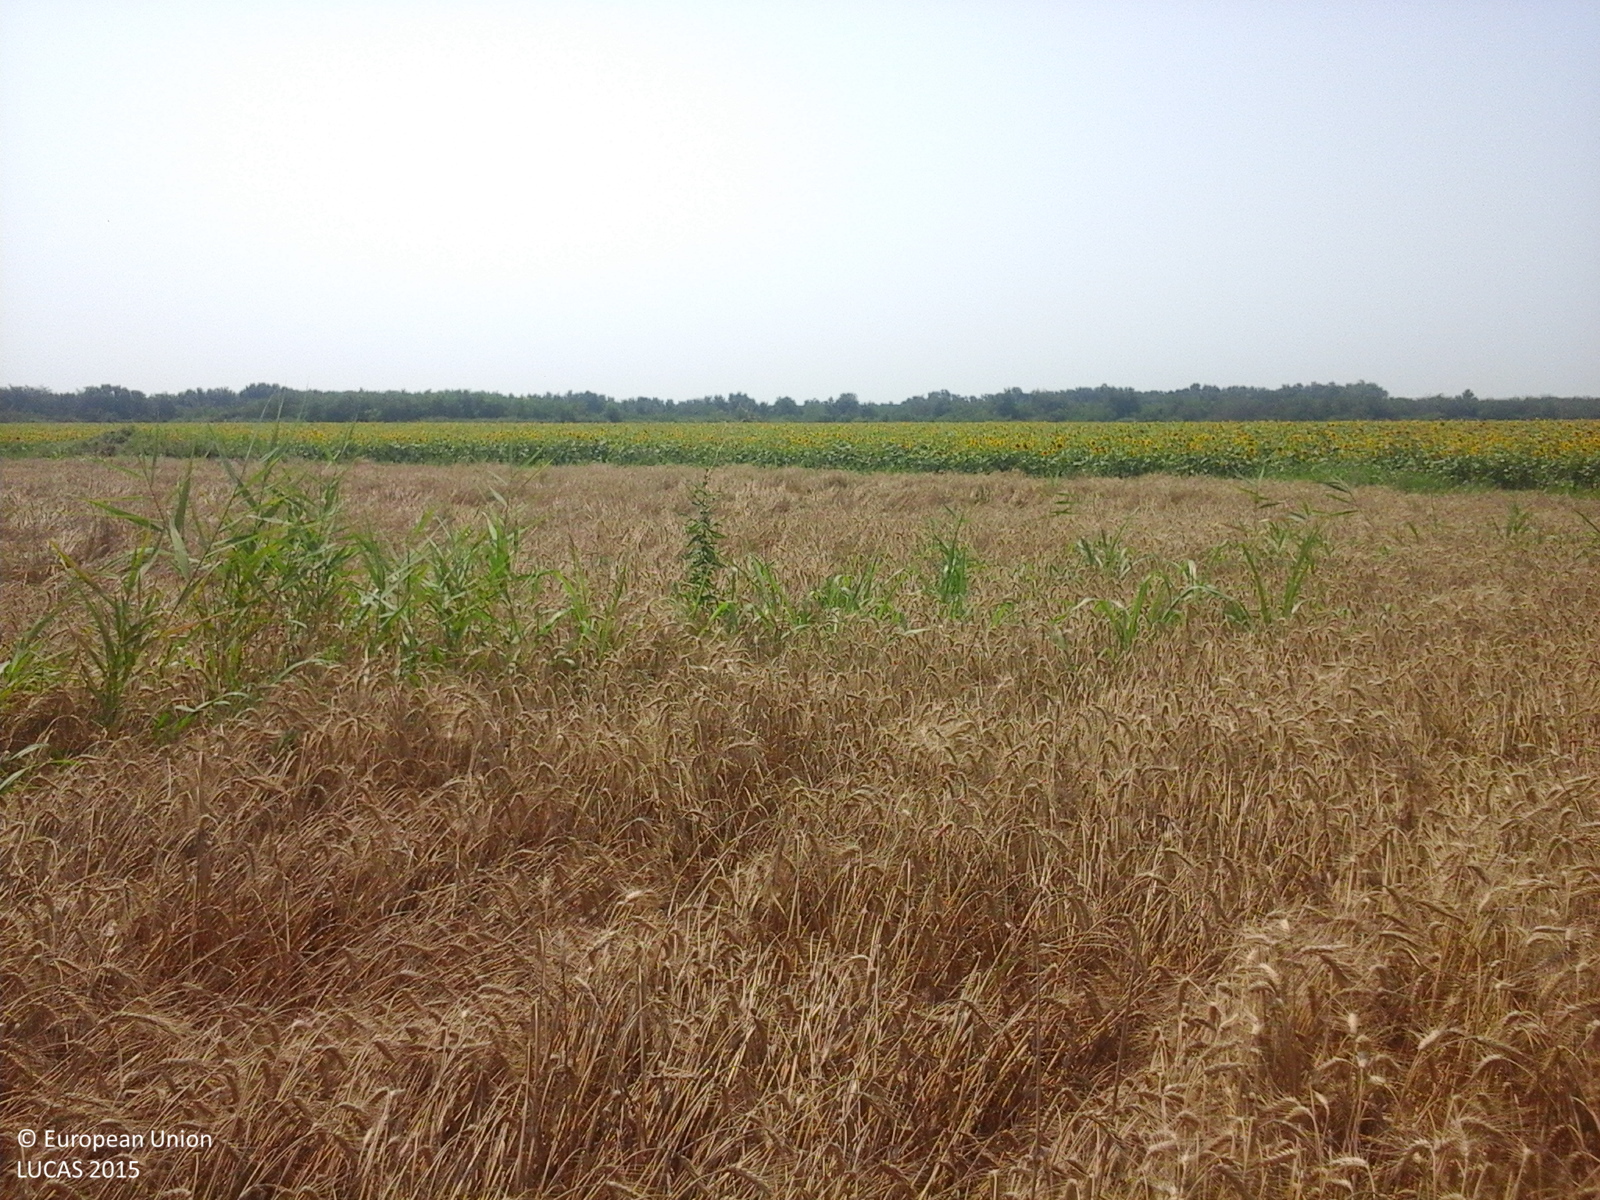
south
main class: Cropland
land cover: Durum wheat
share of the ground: > 75 %
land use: Agriculture (excluding fallow land and kitchen gardens)
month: July
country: RO
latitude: 44.7207
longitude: 26.5438
